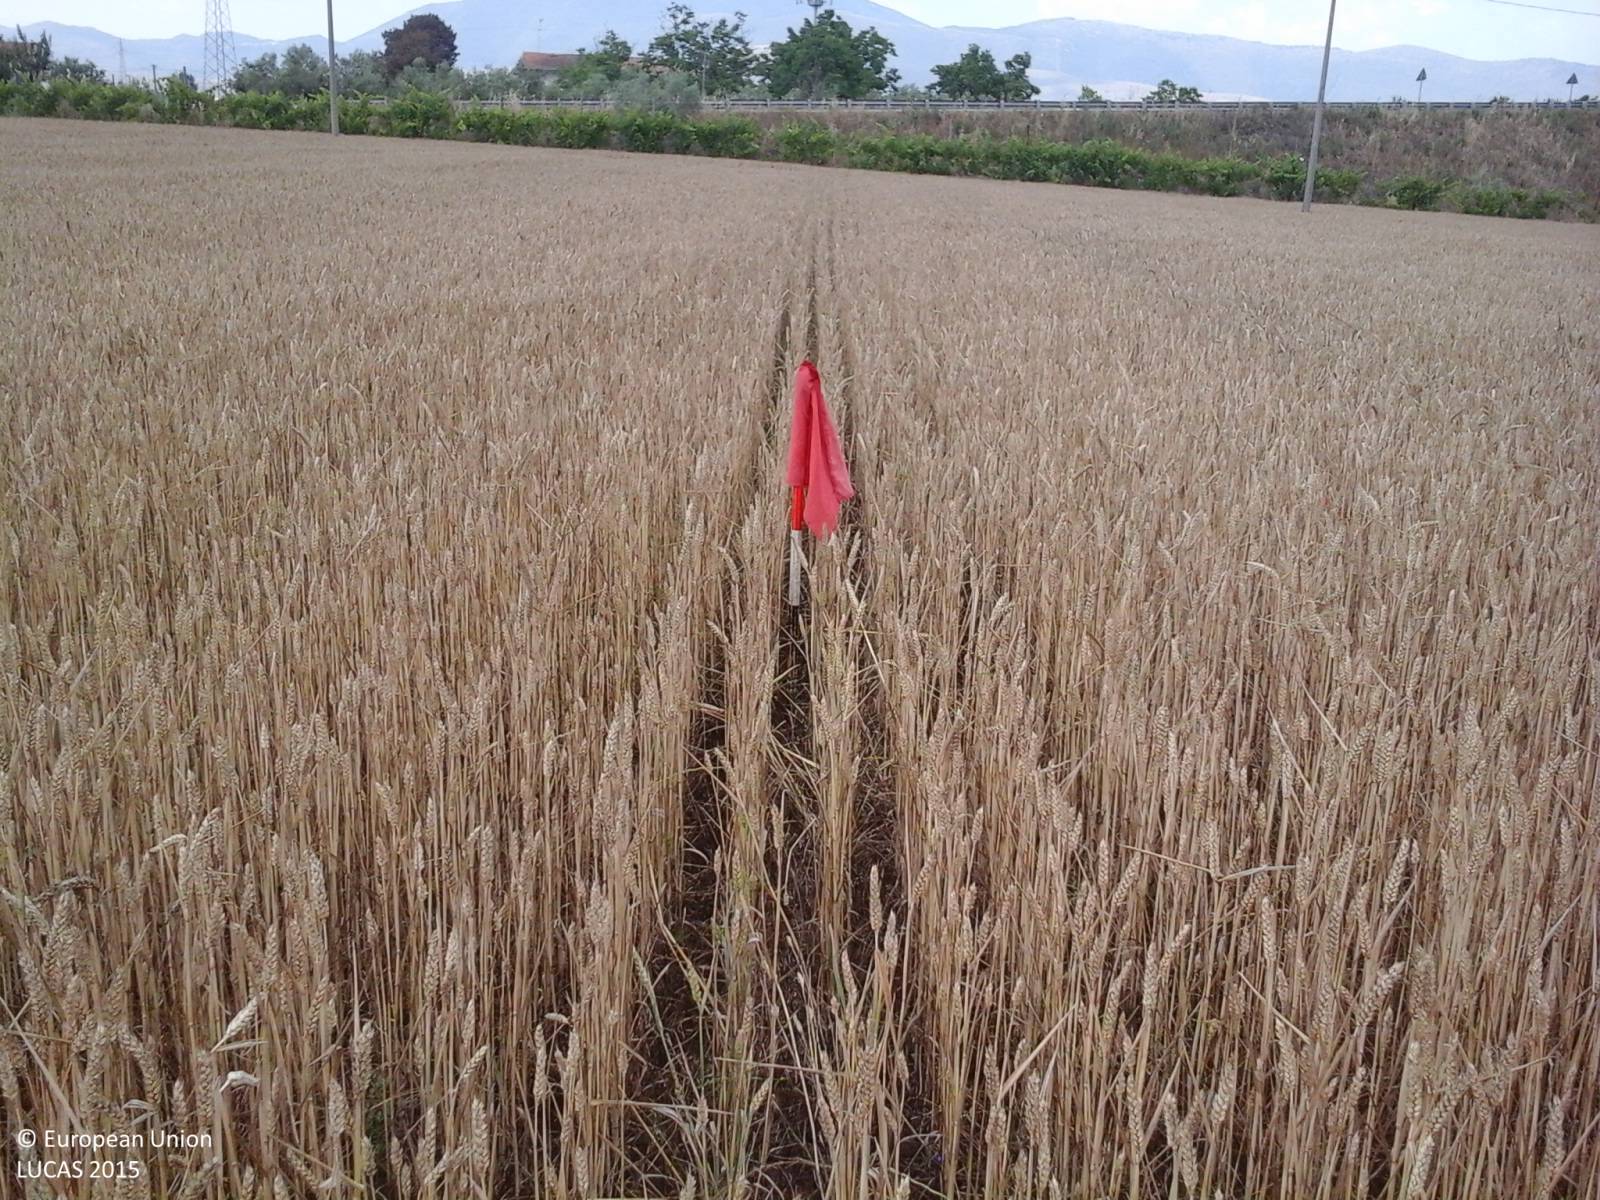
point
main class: Cropland
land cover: Common wheat
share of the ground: > 75 %
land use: Agriculture (excluding fallow land and kitchen gardens)
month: June
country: IT
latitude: 41.1580
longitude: 14.1426
